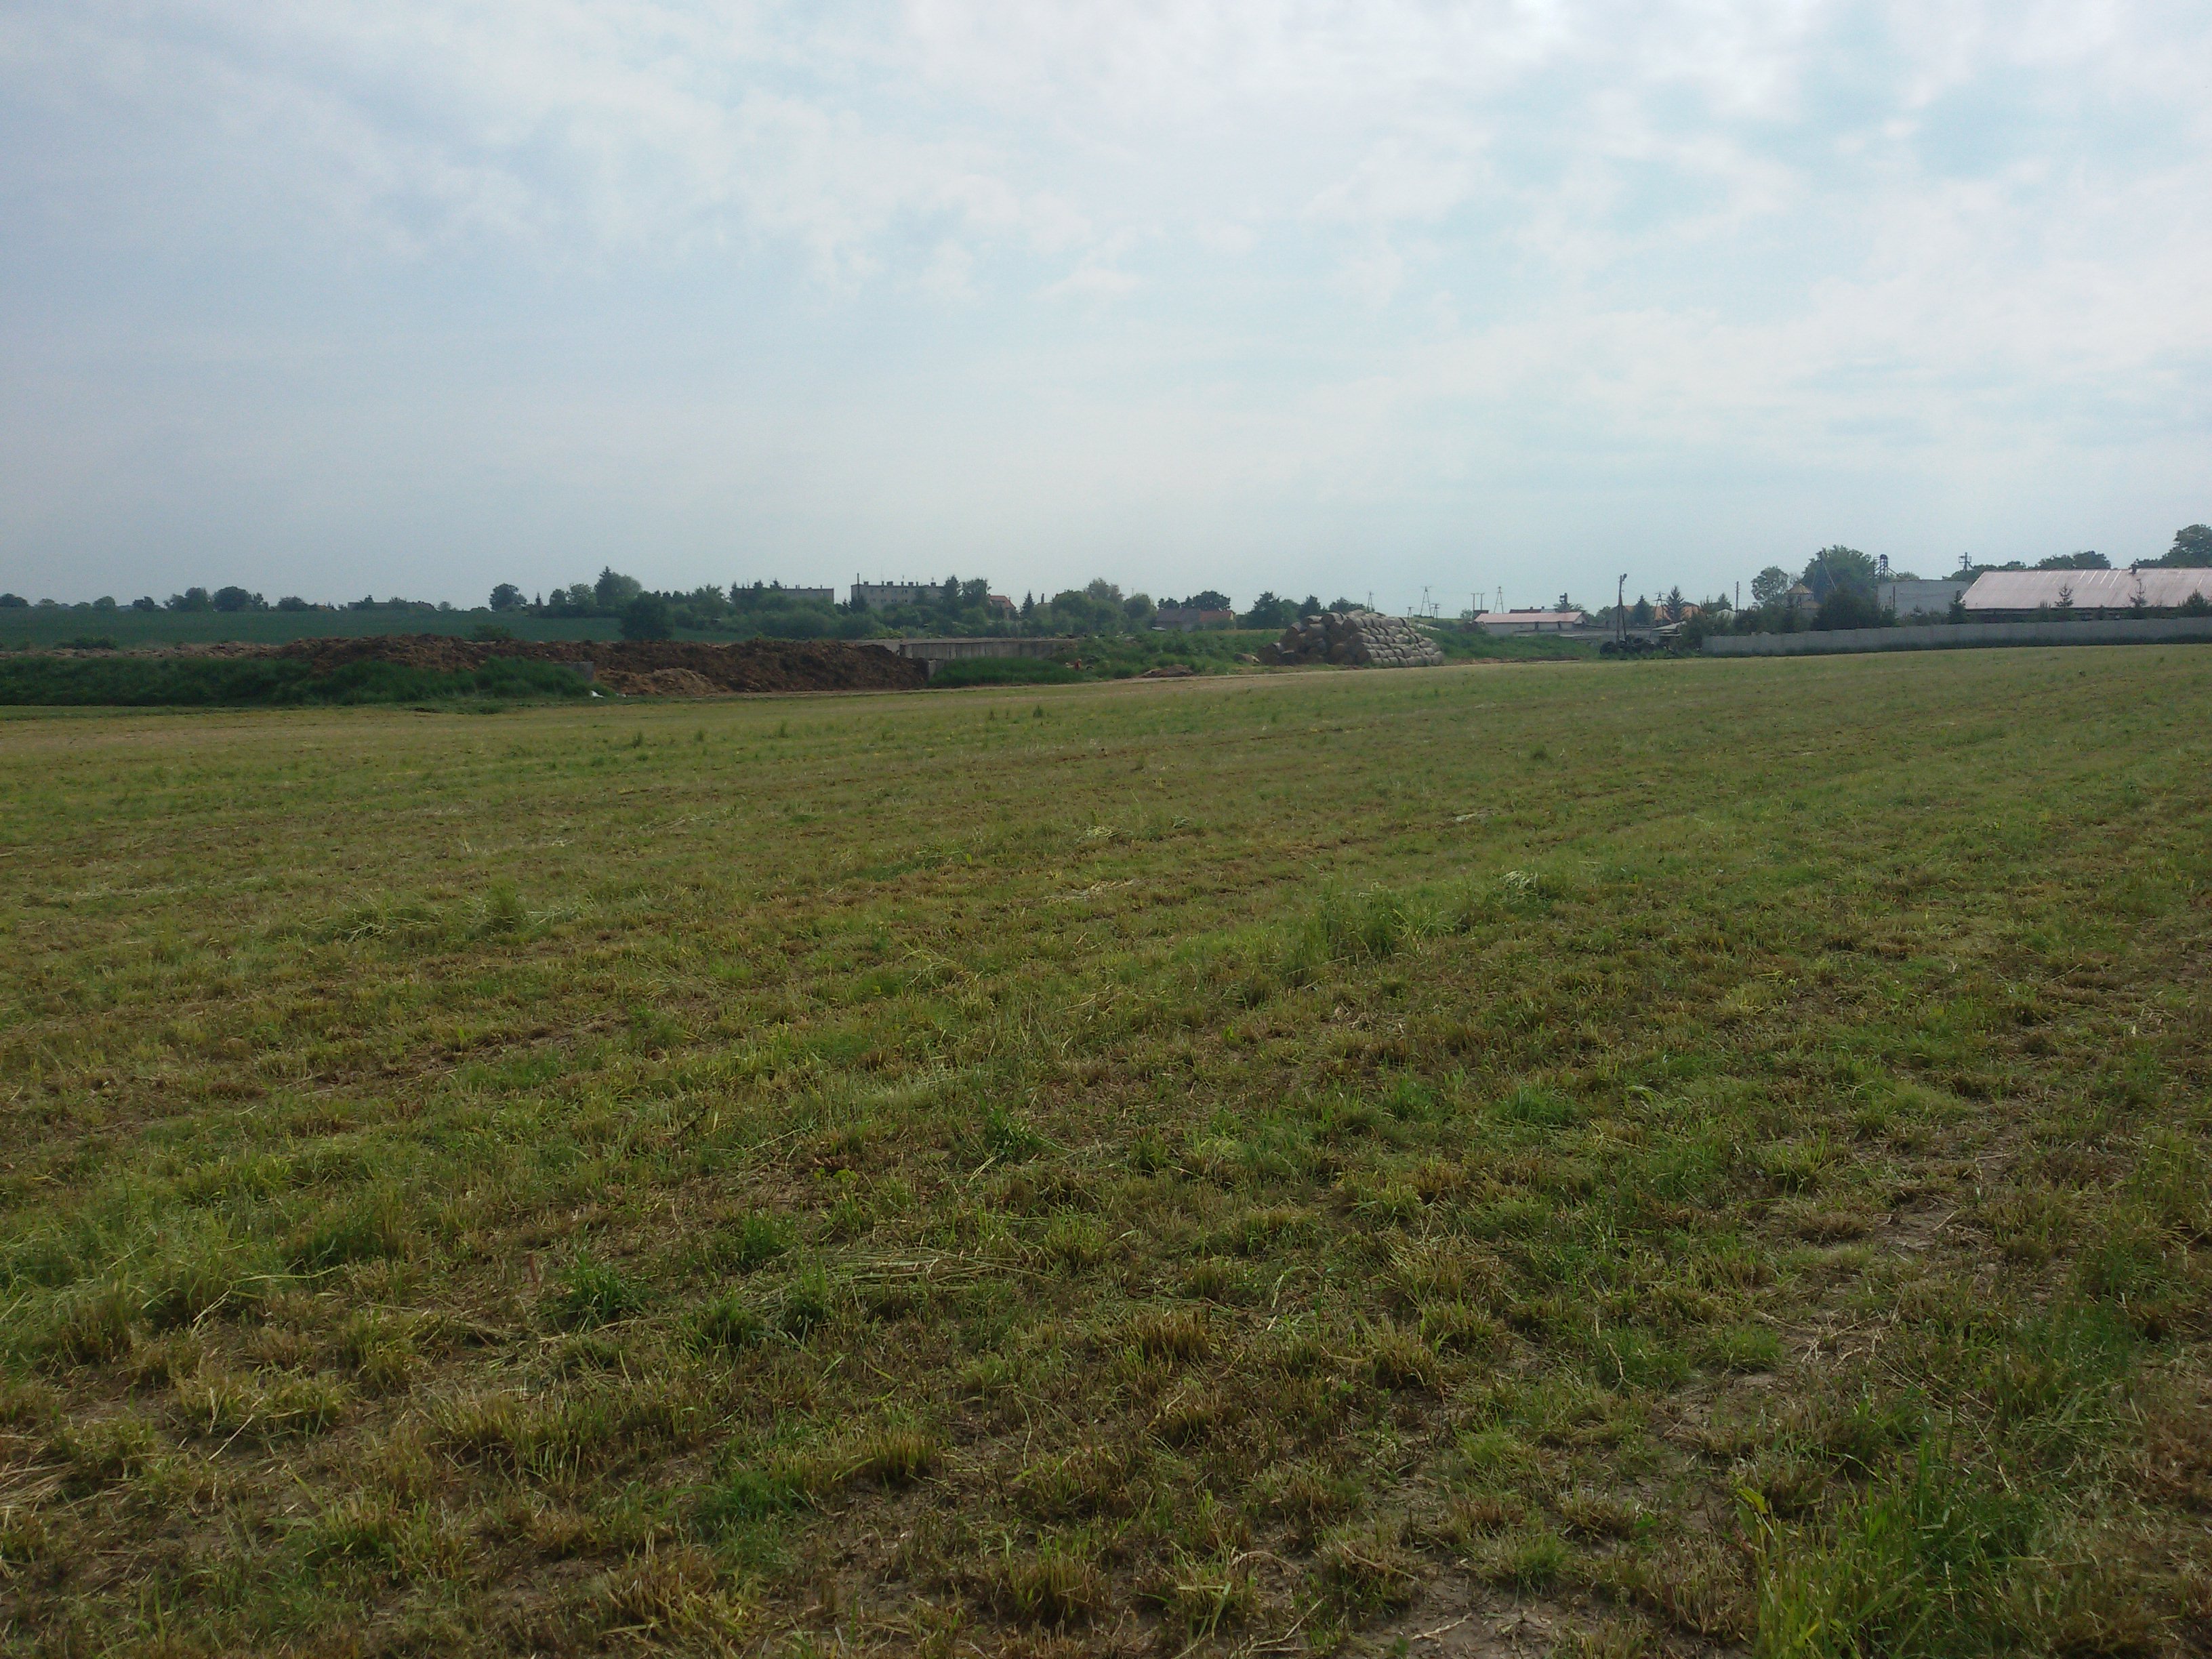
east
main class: Cropland
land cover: Temporary grasslands
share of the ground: > 75 %
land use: Agriculture (excluding fallow land and kitchen gardens)
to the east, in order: Temporary grasslands; Artificial constructions in urban areas
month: May
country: PL
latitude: 50.4989
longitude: 17.1868
